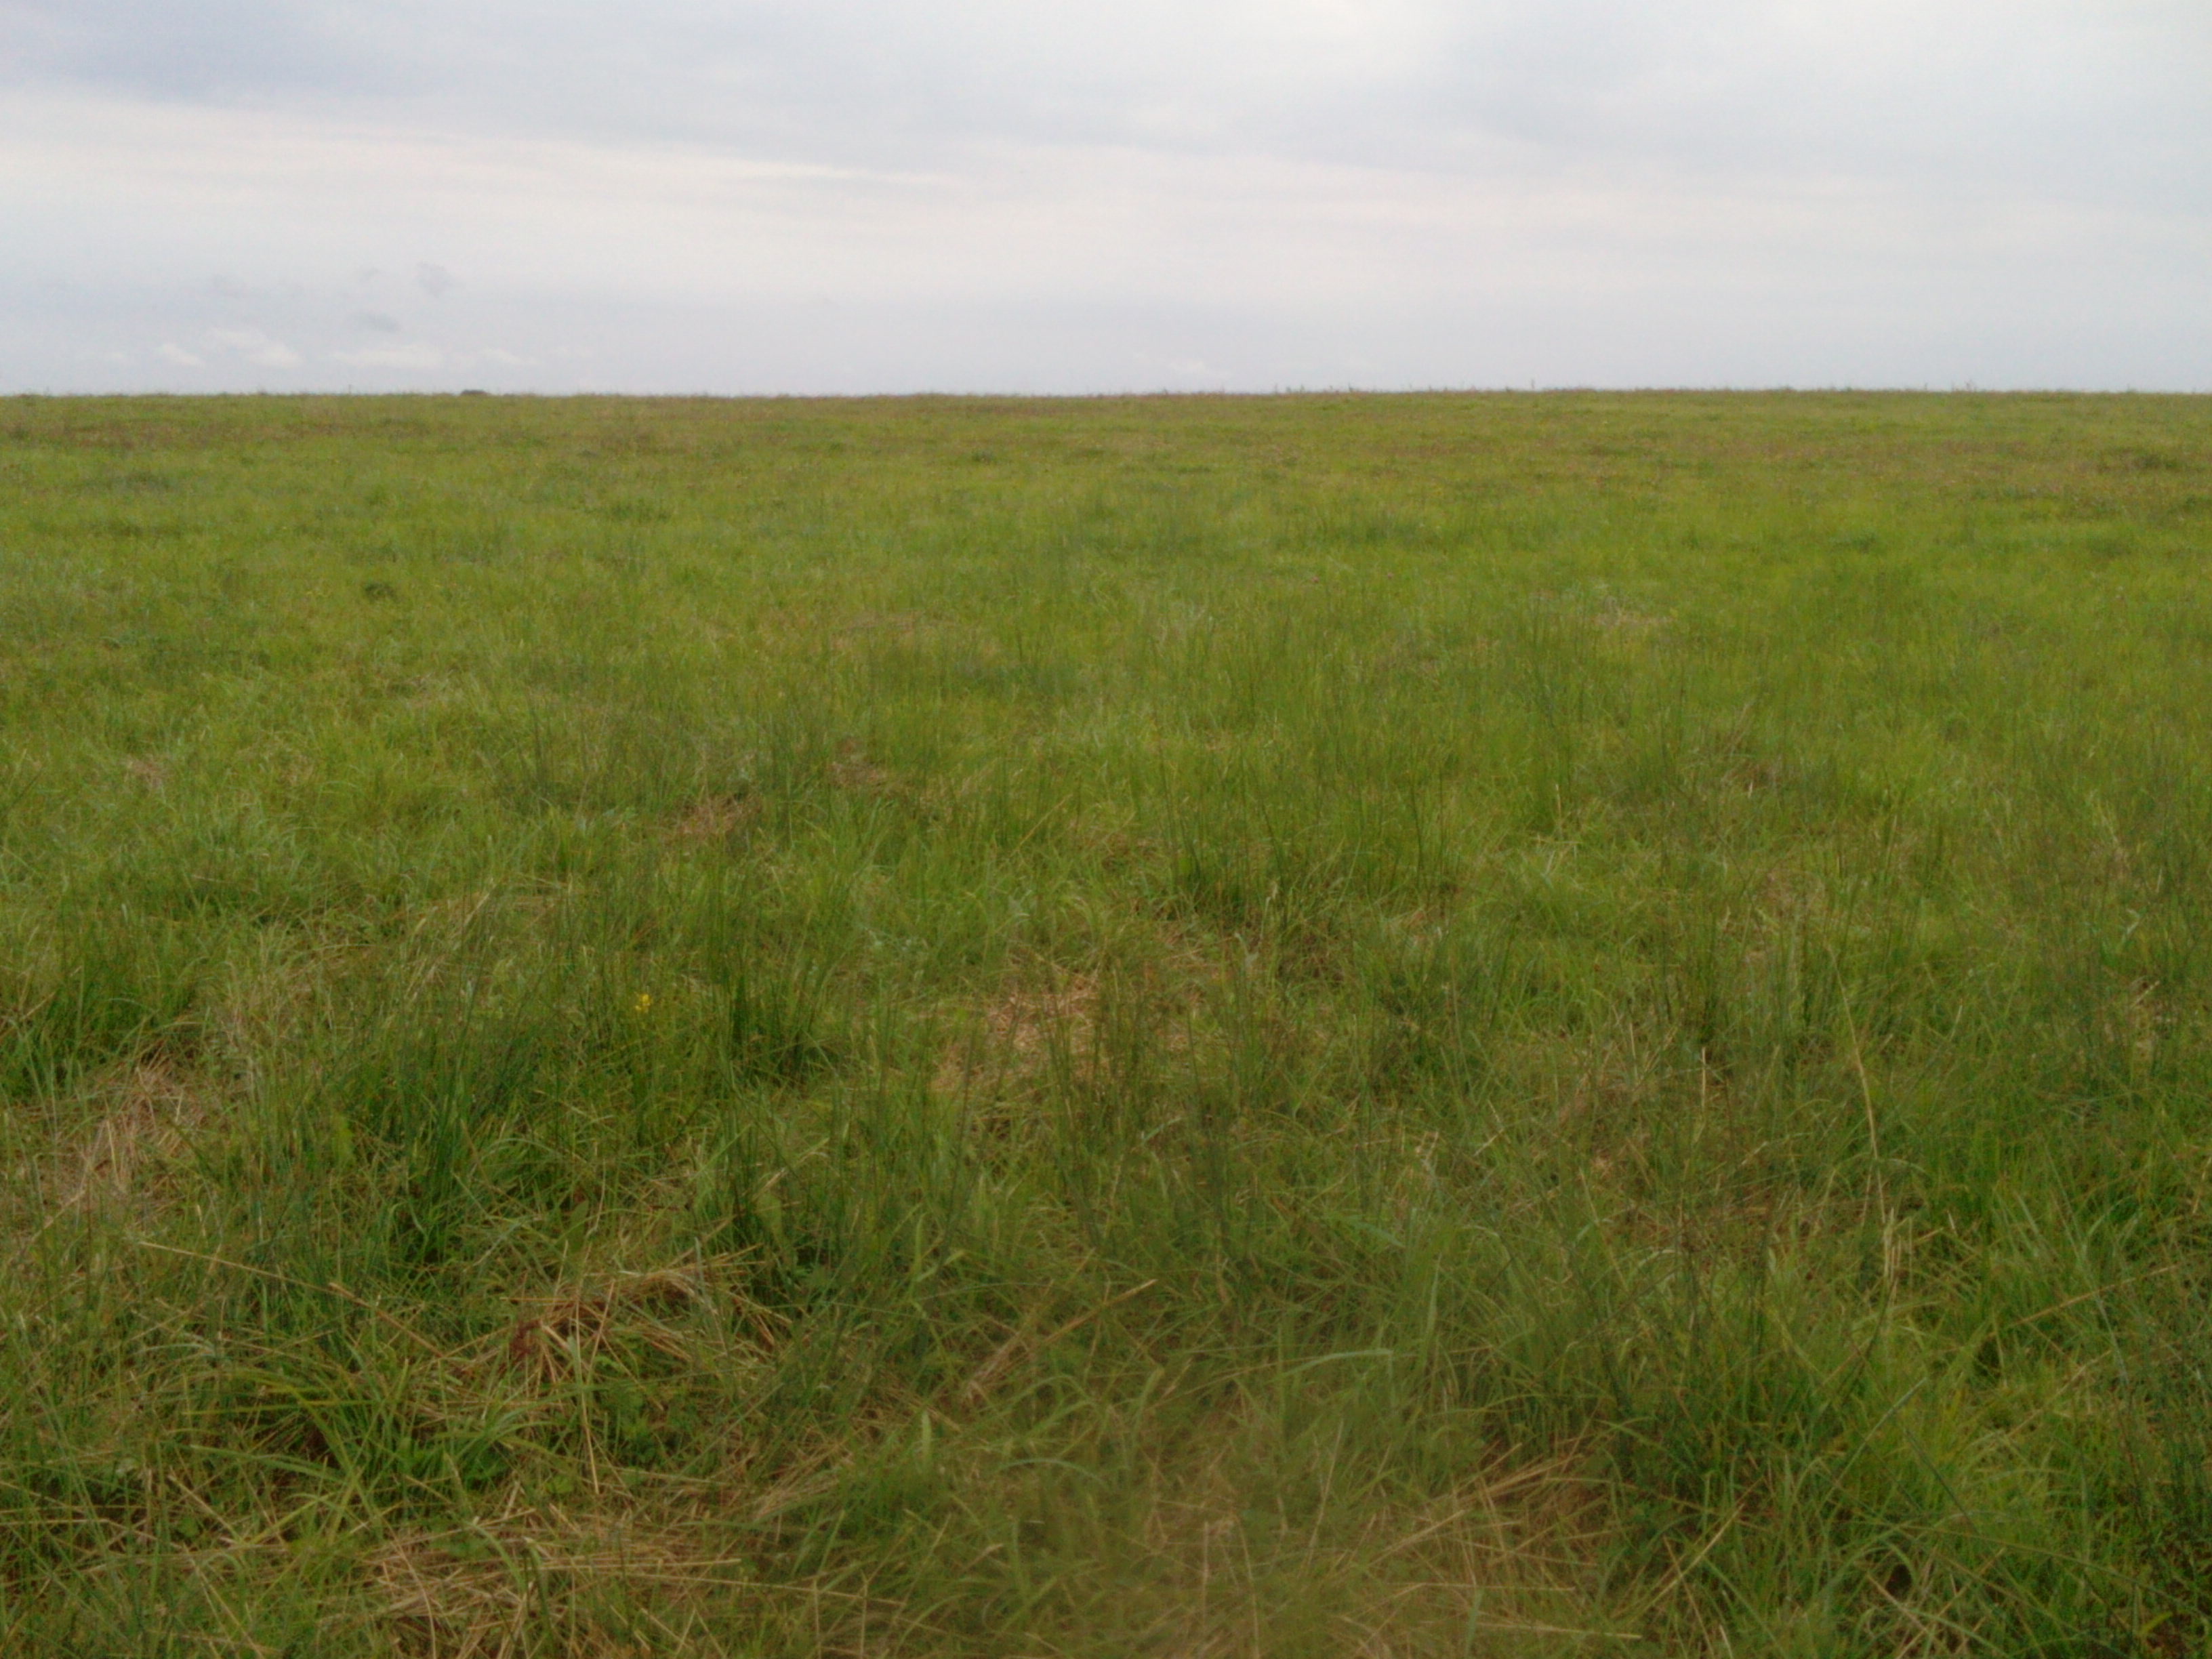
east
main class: Grassland
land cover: Grassland without tree/shrub cover
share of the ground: > 75 %
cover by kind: herbaceous plants 100 %
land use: Agriculture (excluding fallow land and kitchen gardens)
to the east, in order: Grassland without tree/shrub cover
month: September
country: LT
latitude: 55.7156
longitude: 22.7187
